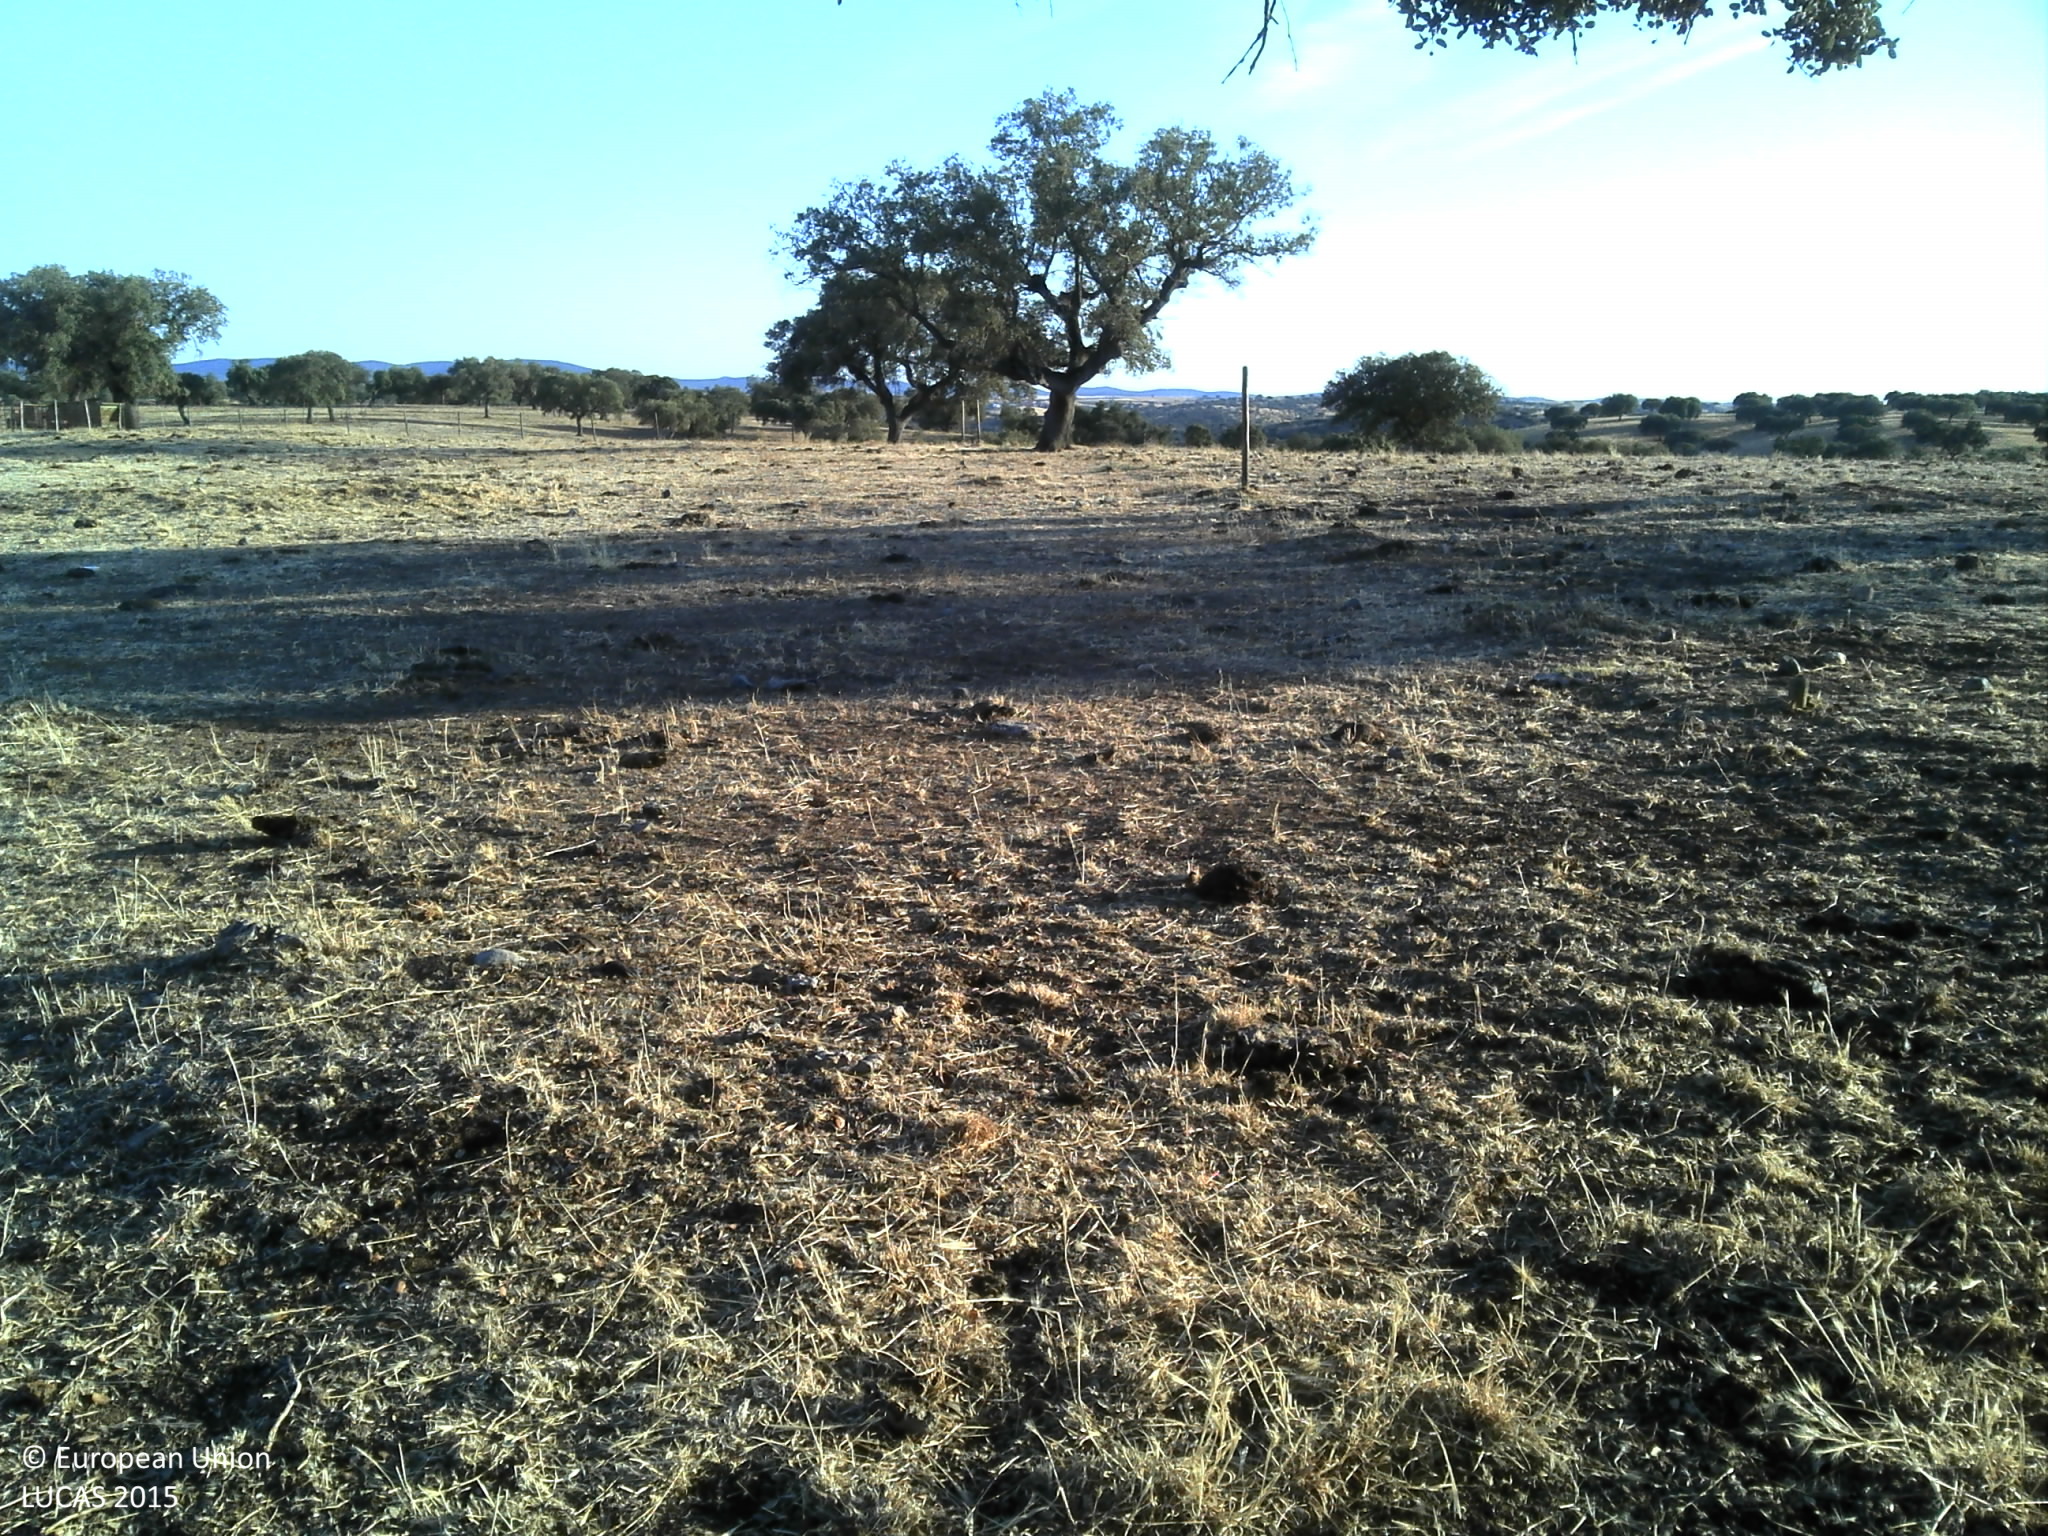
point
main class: Woodland
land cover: Broadleaved woodland
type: broadleaved evergreen forest
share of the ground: 10 - 25 %
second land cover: Grassland without tree/shrub cover
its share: 10 - 25 %
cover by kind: unconsolidated bare surface 70 %, broadleaved forest trees 15 %, herbaceous plants 15 %
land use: Forestry
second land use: Agriculture (excluding fallow land and kitchen gardens)
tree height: > 5 m
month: July
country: PT
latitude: 38.1658
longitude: -7.2866
